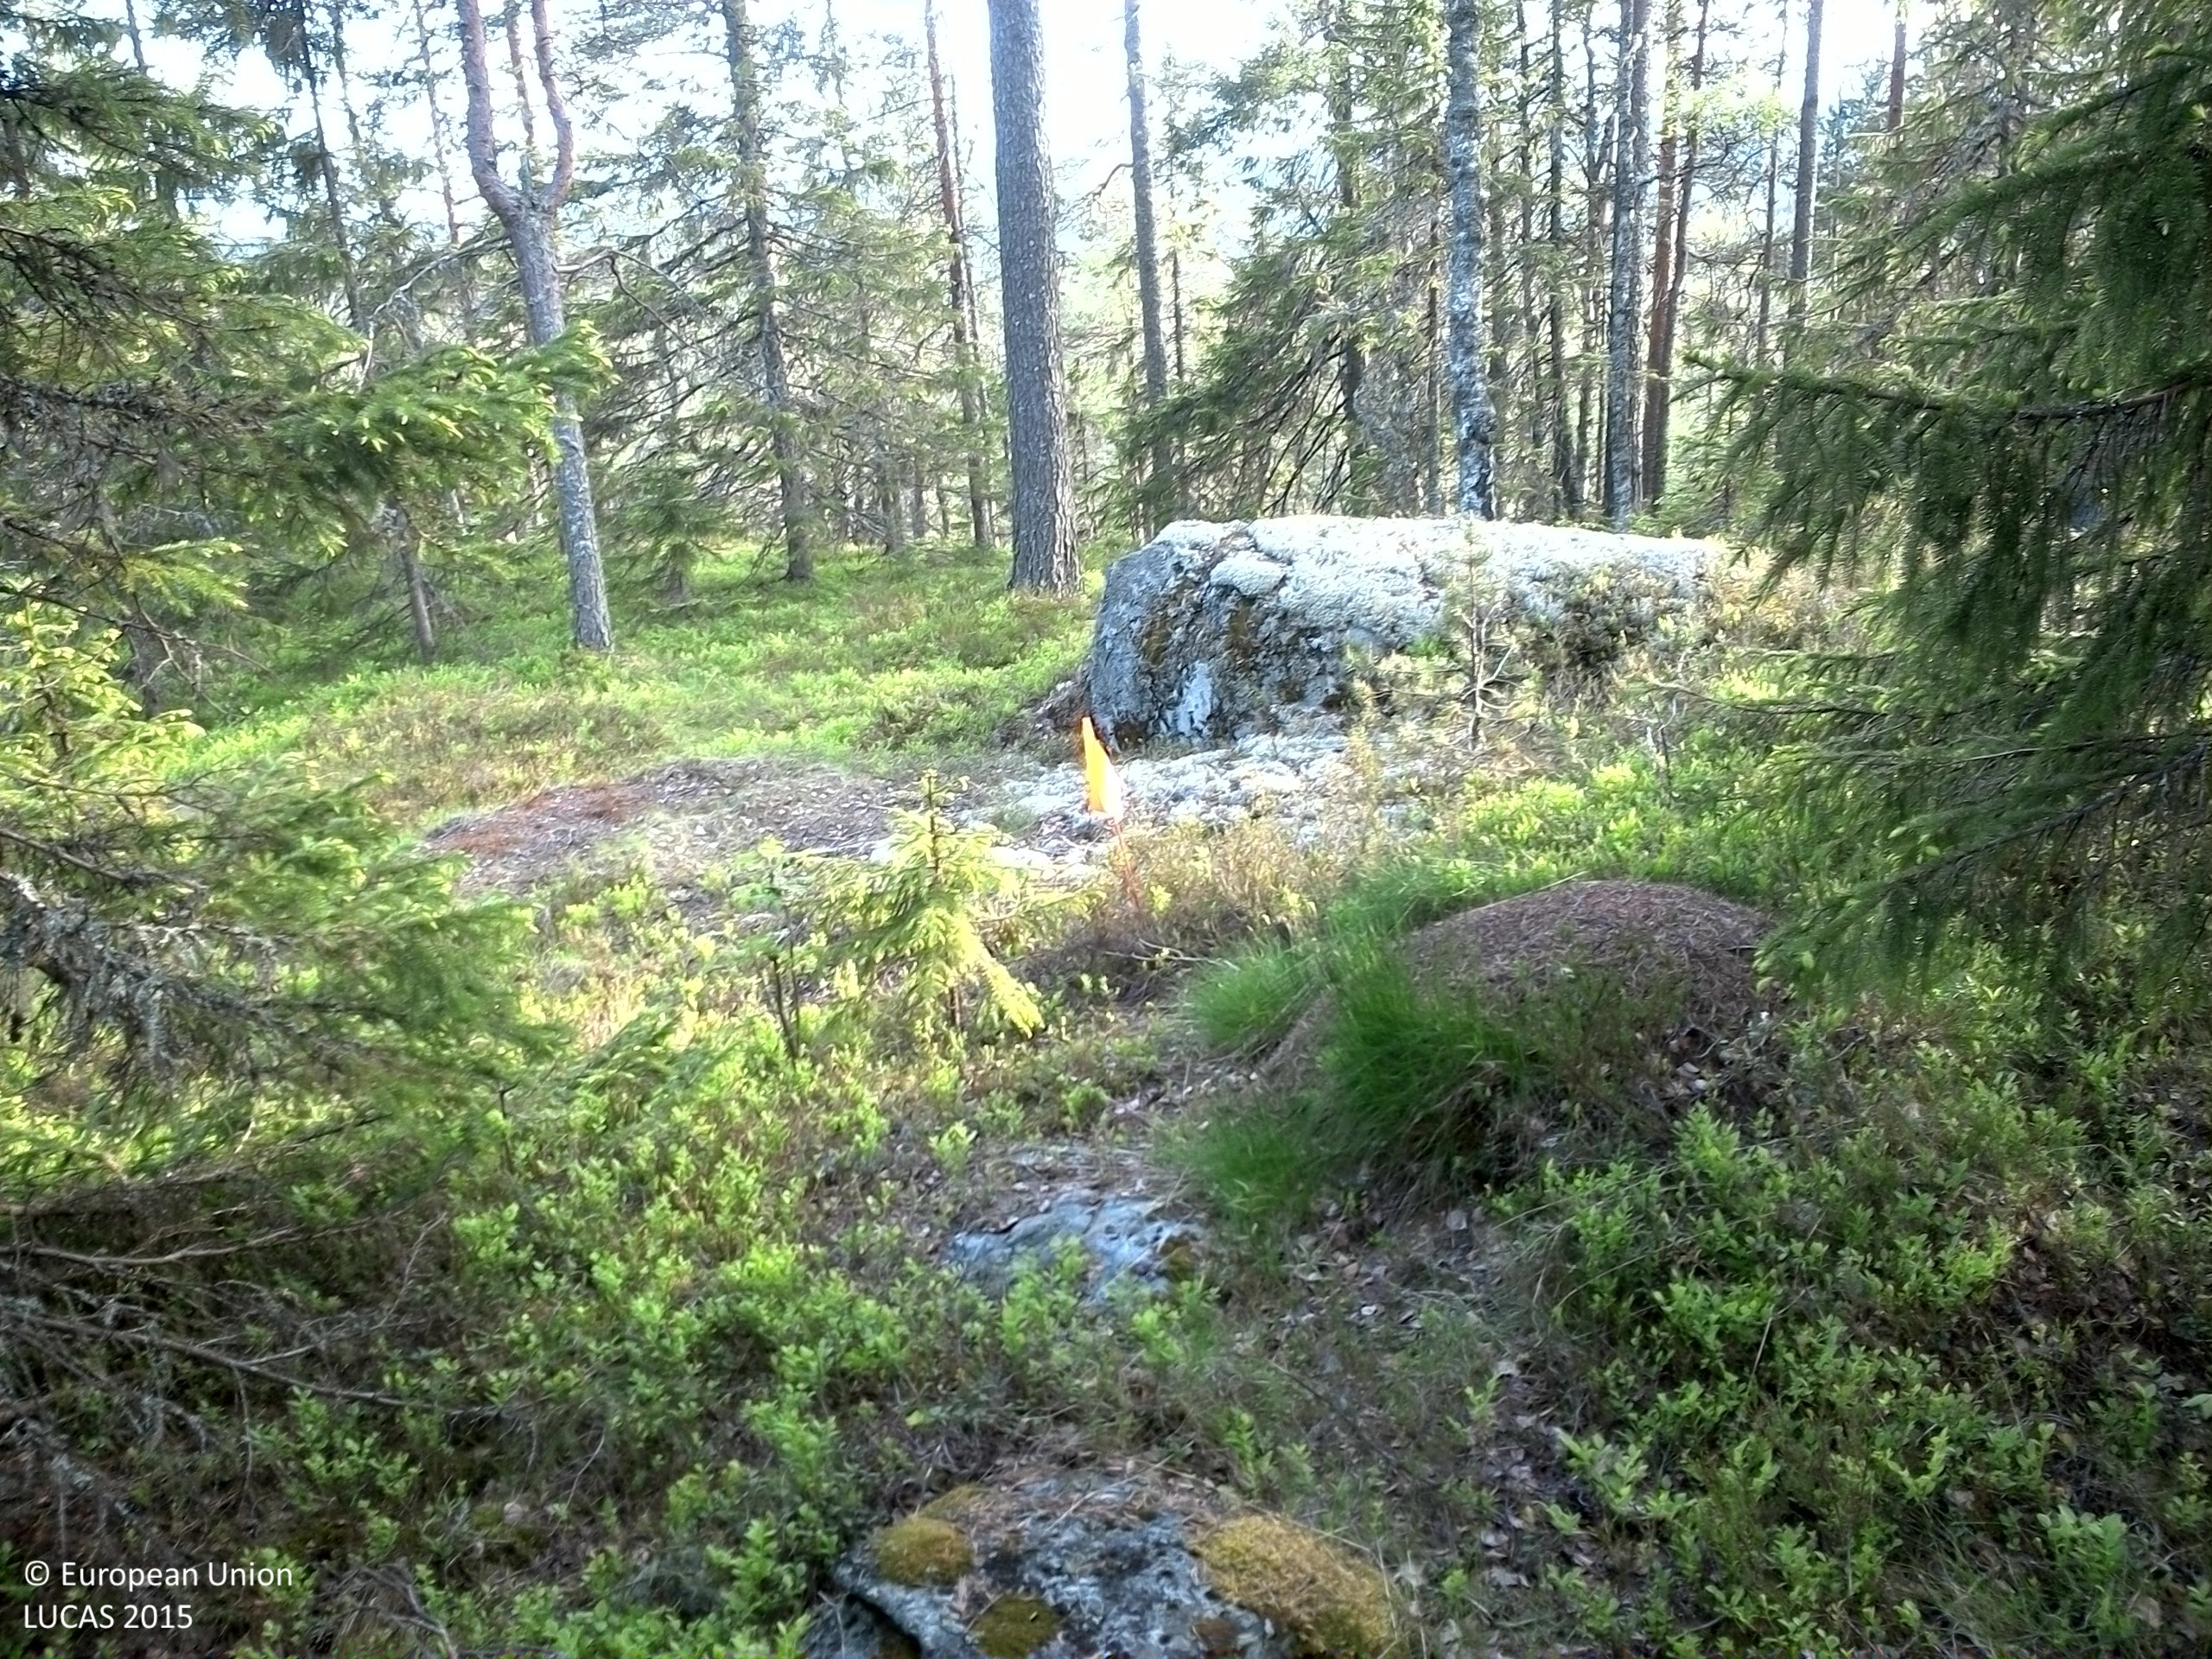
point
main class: Woodland
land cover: Other coniferous woodland
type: boreal forest
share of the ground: 25 - 50 %
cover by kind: shrubs 60 %, coniferous forest trees 25 %, lichens and mosses 10 %, broadleaved forest trees 5 %
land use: Forestry
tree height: > 5 m
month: June
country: SE
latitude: 62.6395
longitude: 17.5664
